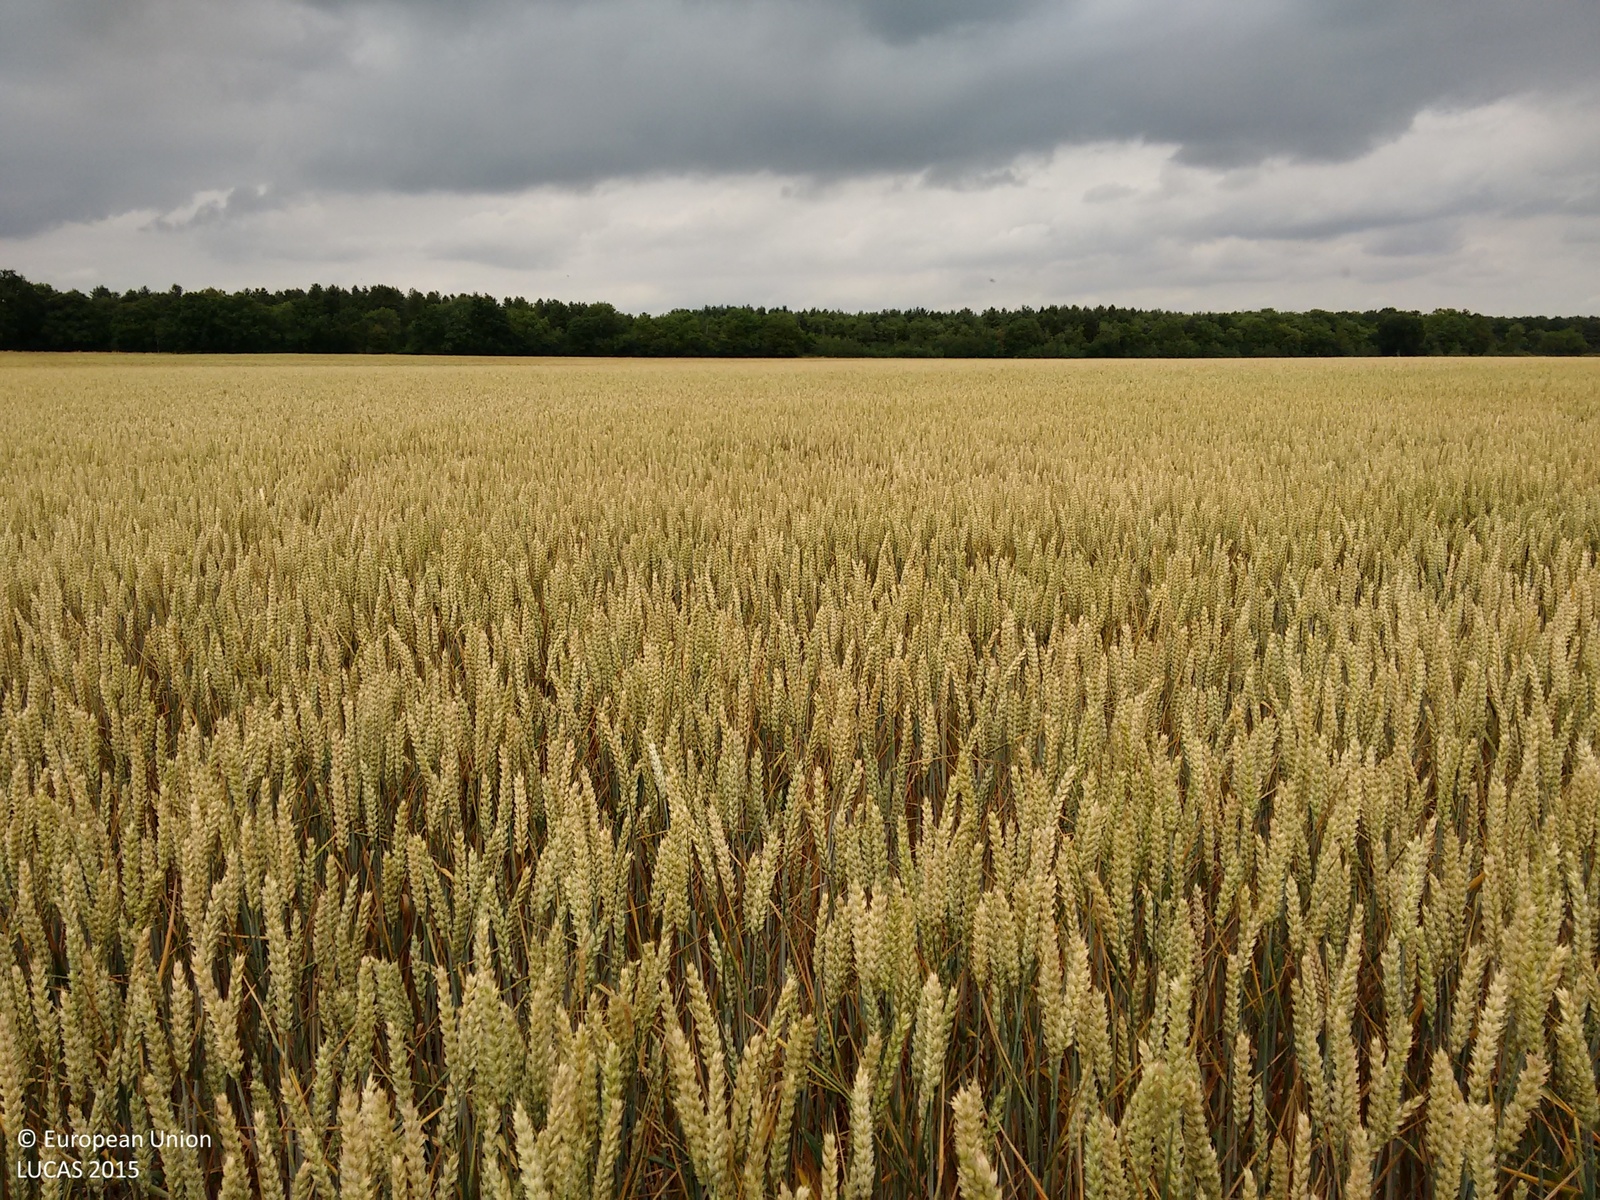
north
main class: Cropland
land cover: Common wheat
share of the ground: > 75 %
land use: Agriculture (excluding fallow land and kitchen gardens)
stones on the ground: 25 - 50 %
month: July
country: GB
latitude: 52.5787
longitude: -0.5308
